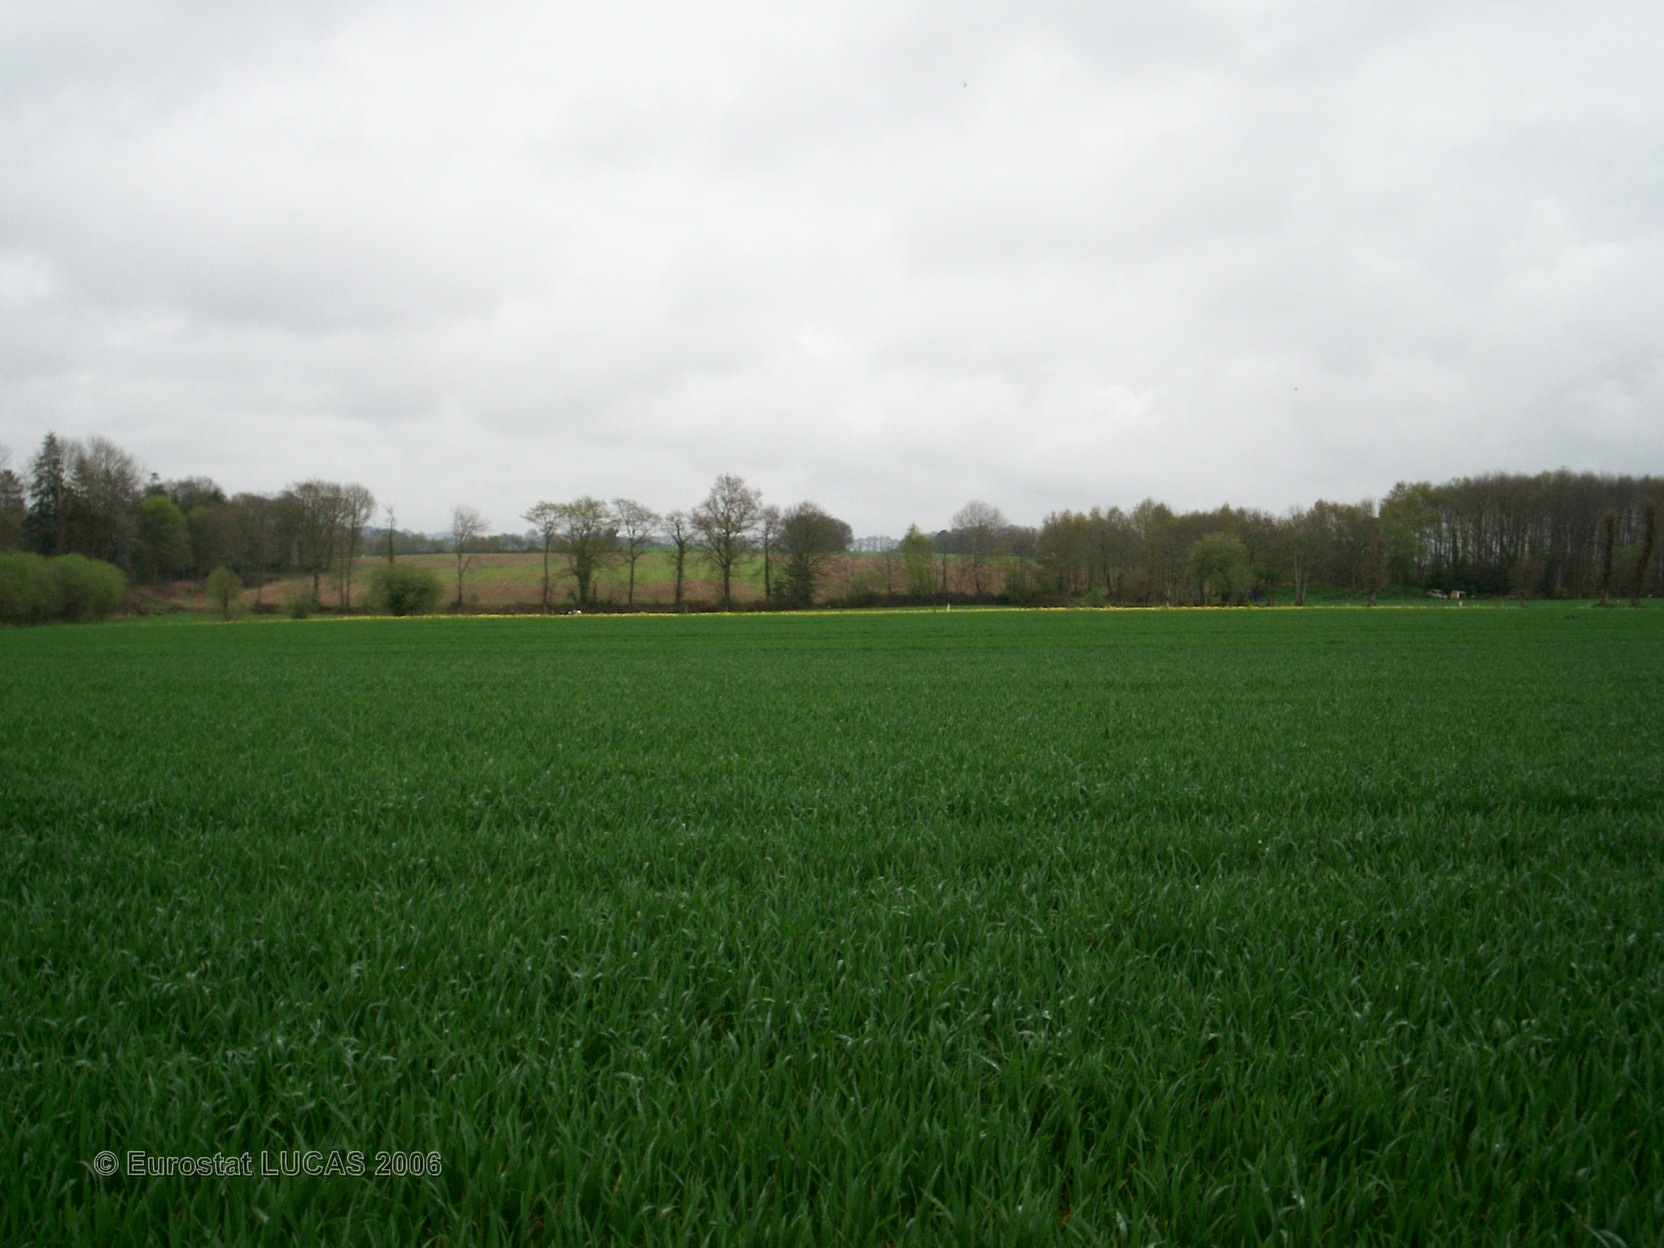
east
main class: Cropland
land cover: Triticale
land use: Agriculture (excluding fallow land and kitchen gardens)
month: April
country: FR
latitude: 48.1706
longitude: -2.4440
